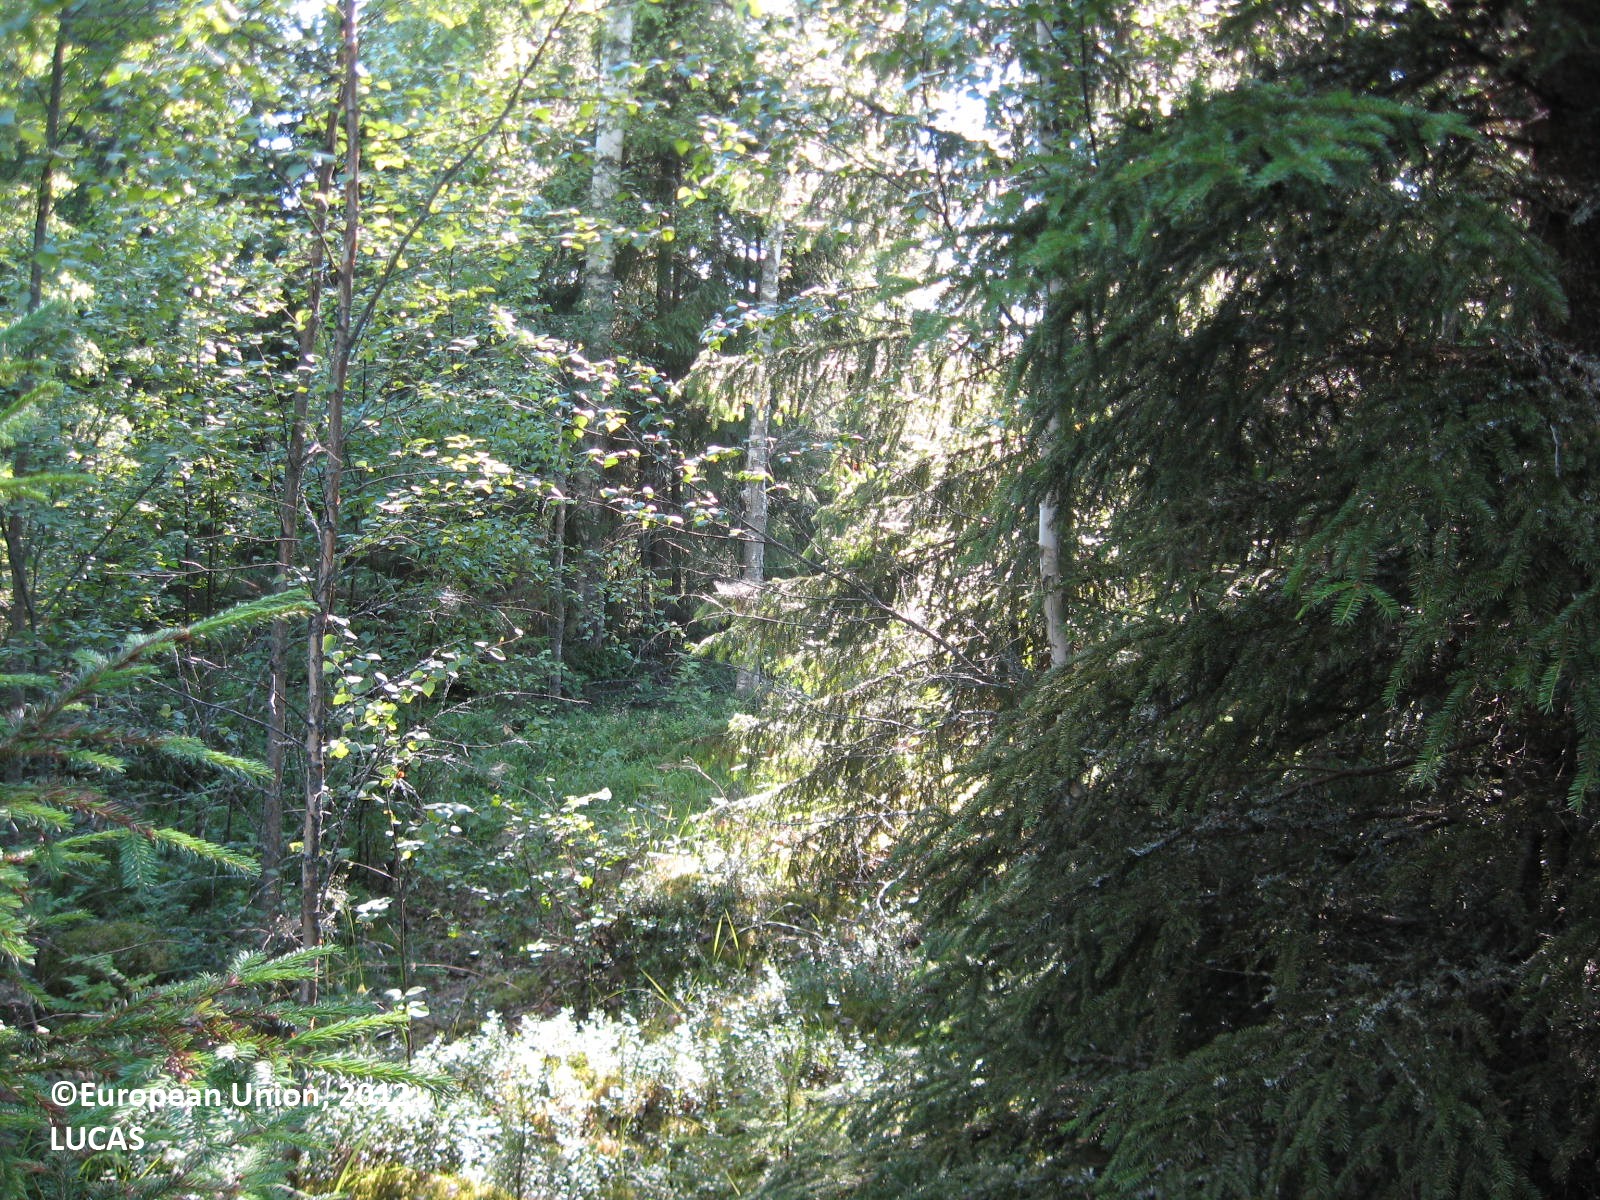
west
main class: Woodland
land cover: Spruce dominated coniferous woodland
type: boreal forest
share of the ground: > 75 %
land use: Forestry
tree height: > 5 m
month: July
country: FI
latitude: 62.1696
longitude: 21.5086
